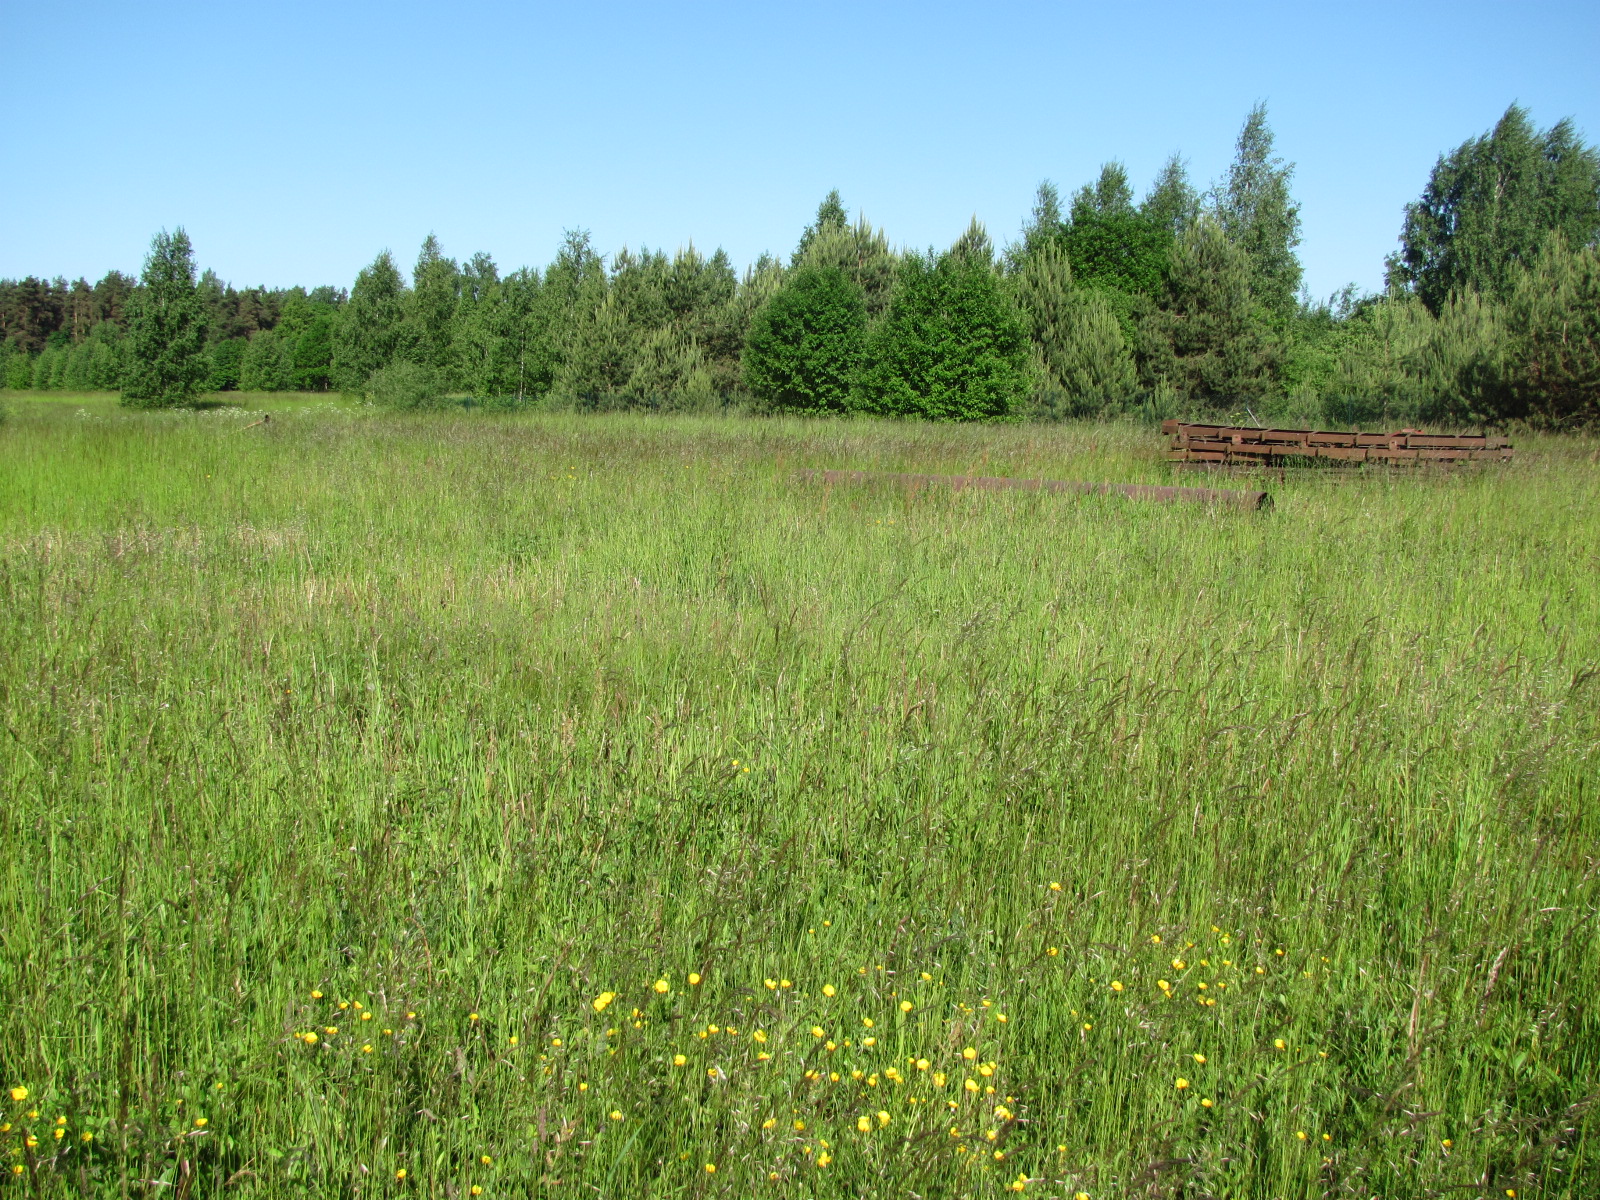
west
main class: Grassland
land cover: Grassland without tree/shrub cover
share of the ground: > 75 %
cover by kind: herbaceous plants 100 %
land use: Residential
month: June
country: LV
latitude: 56.8516
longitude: 24.2396
